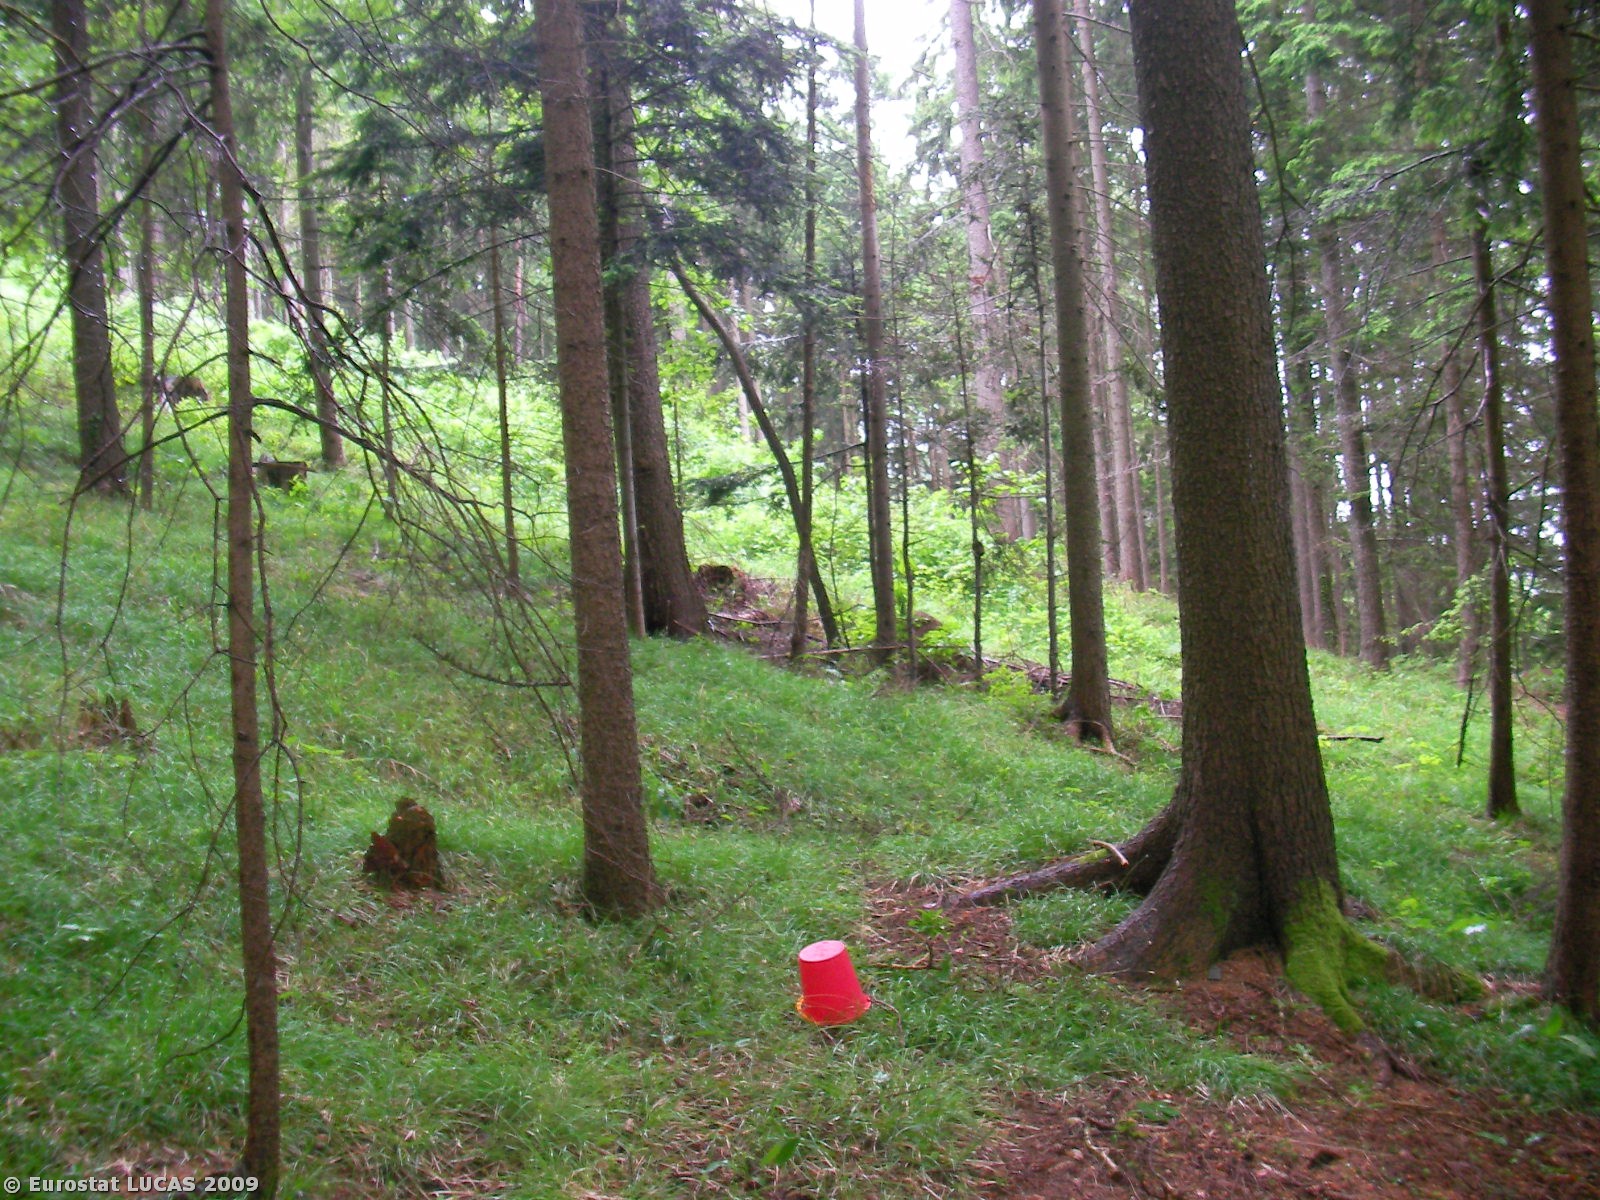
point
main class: Woodland
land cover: Coniferous woodland
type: alpine coniferous forest
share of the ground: > 75 %
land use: Forestry
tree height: > 5 m
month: May
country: AT
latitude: 47.2712
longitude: 15.5654
